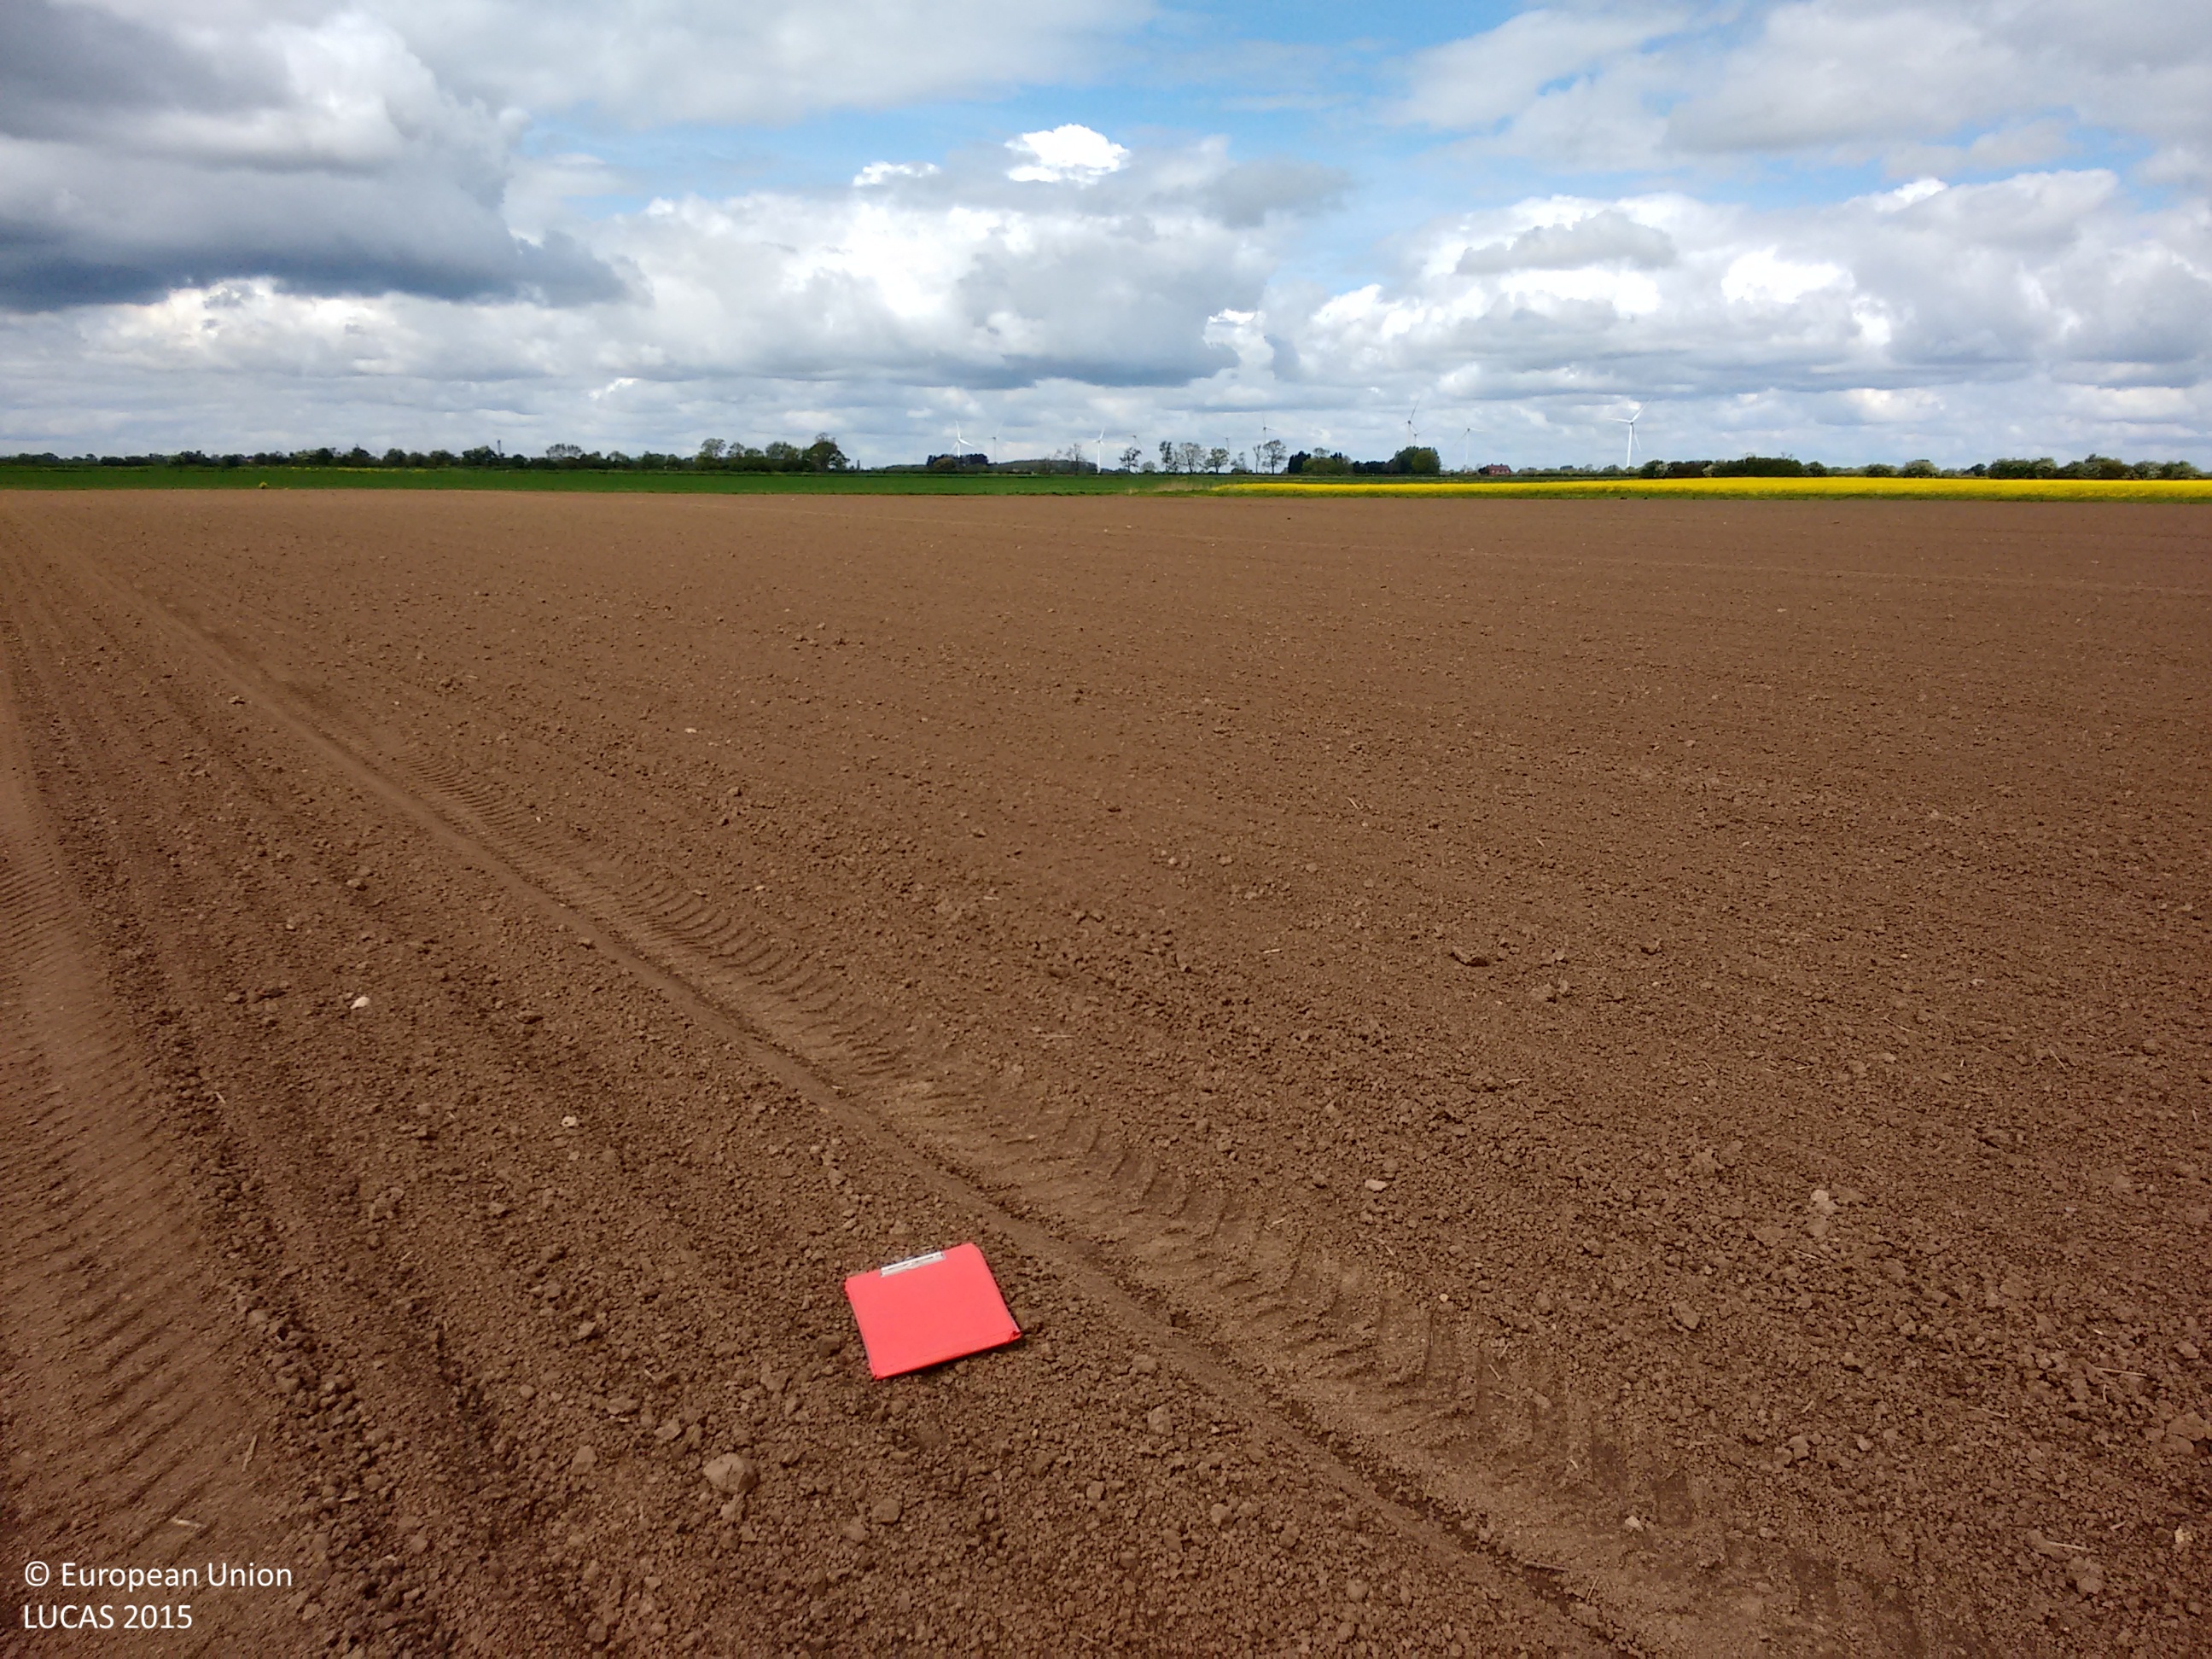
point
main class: Cropland
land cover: Dry pulses
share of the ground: > 75 %
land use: Agriculture (excluding fallow land and kitchen gardens)
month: May
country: GB
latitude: 53.7199
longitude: -0.7539
